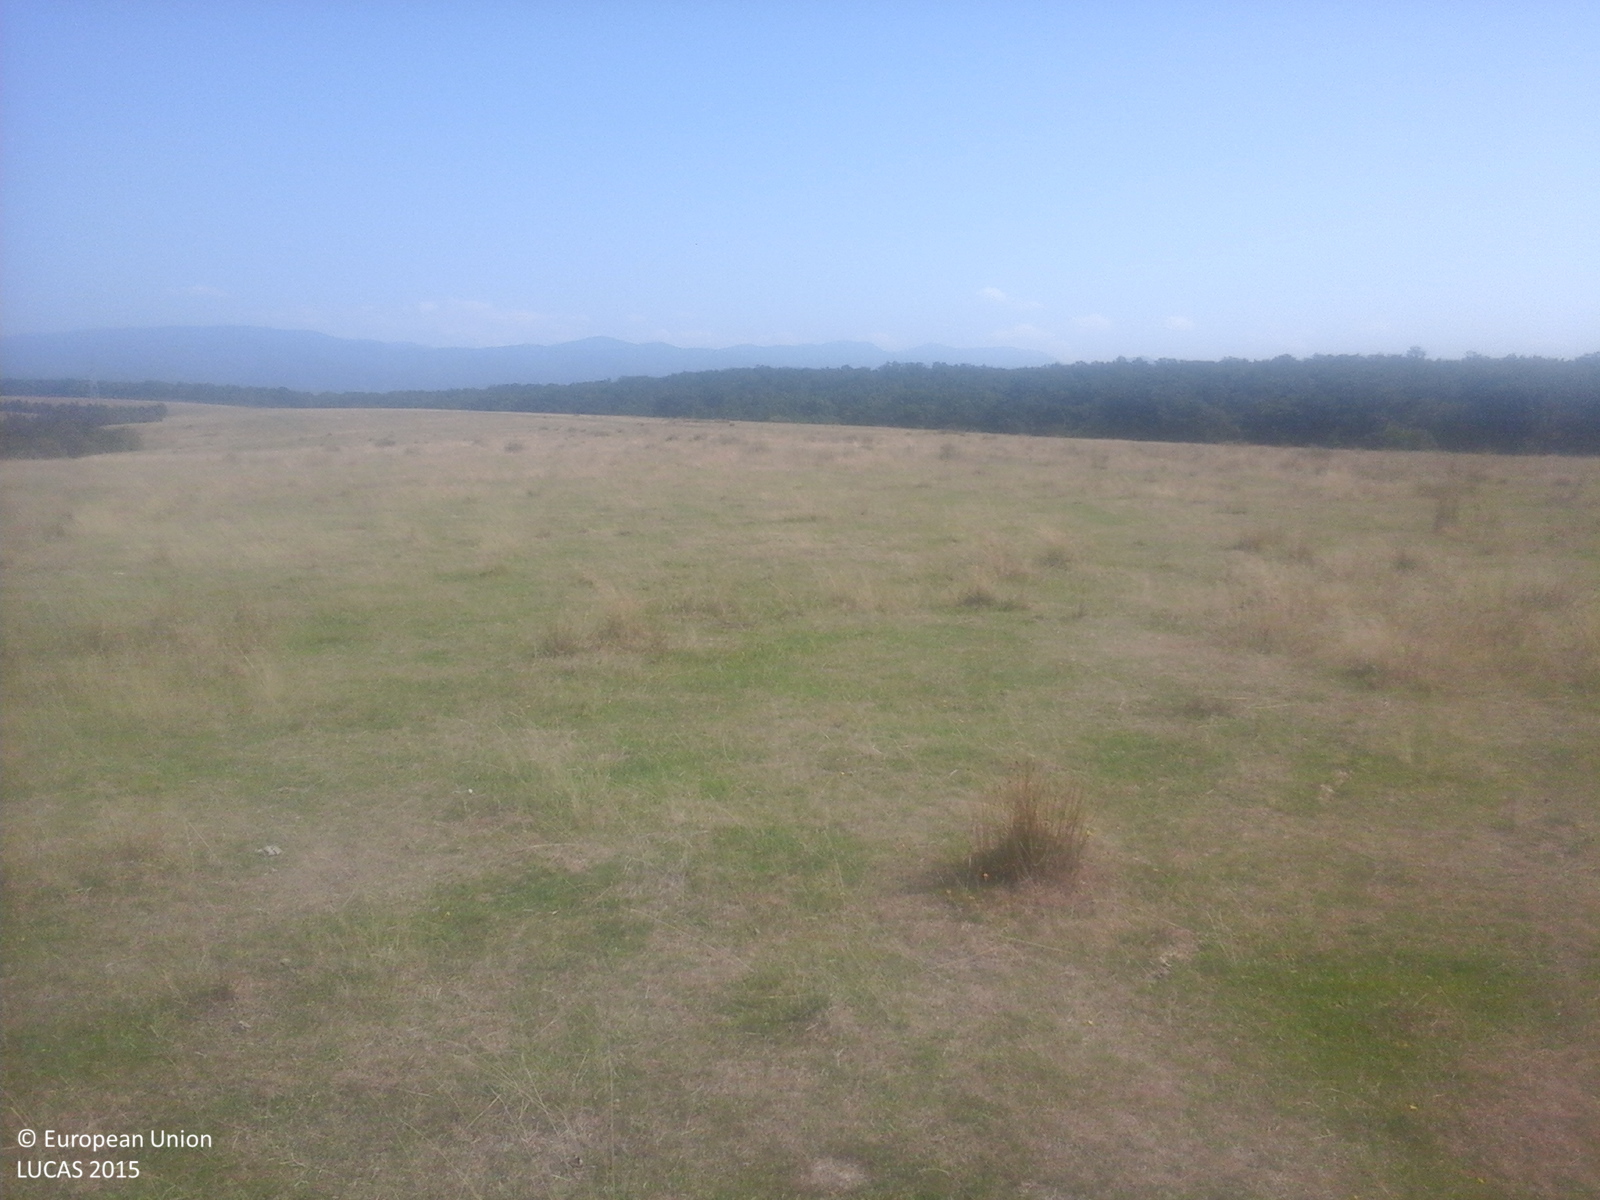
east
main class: Grassland
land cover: Grassland without tree/shrub cover
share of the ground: > 75 %
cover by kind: herbaceous plants 100 %
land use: Agriculture (excluding fallow land and kitchen gardens)
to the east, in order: Grassland without tree/shrub cover; Tracks; Grassland without tree/shrub cover
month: September
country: RO
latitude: 46.6881
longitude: 22.3543
